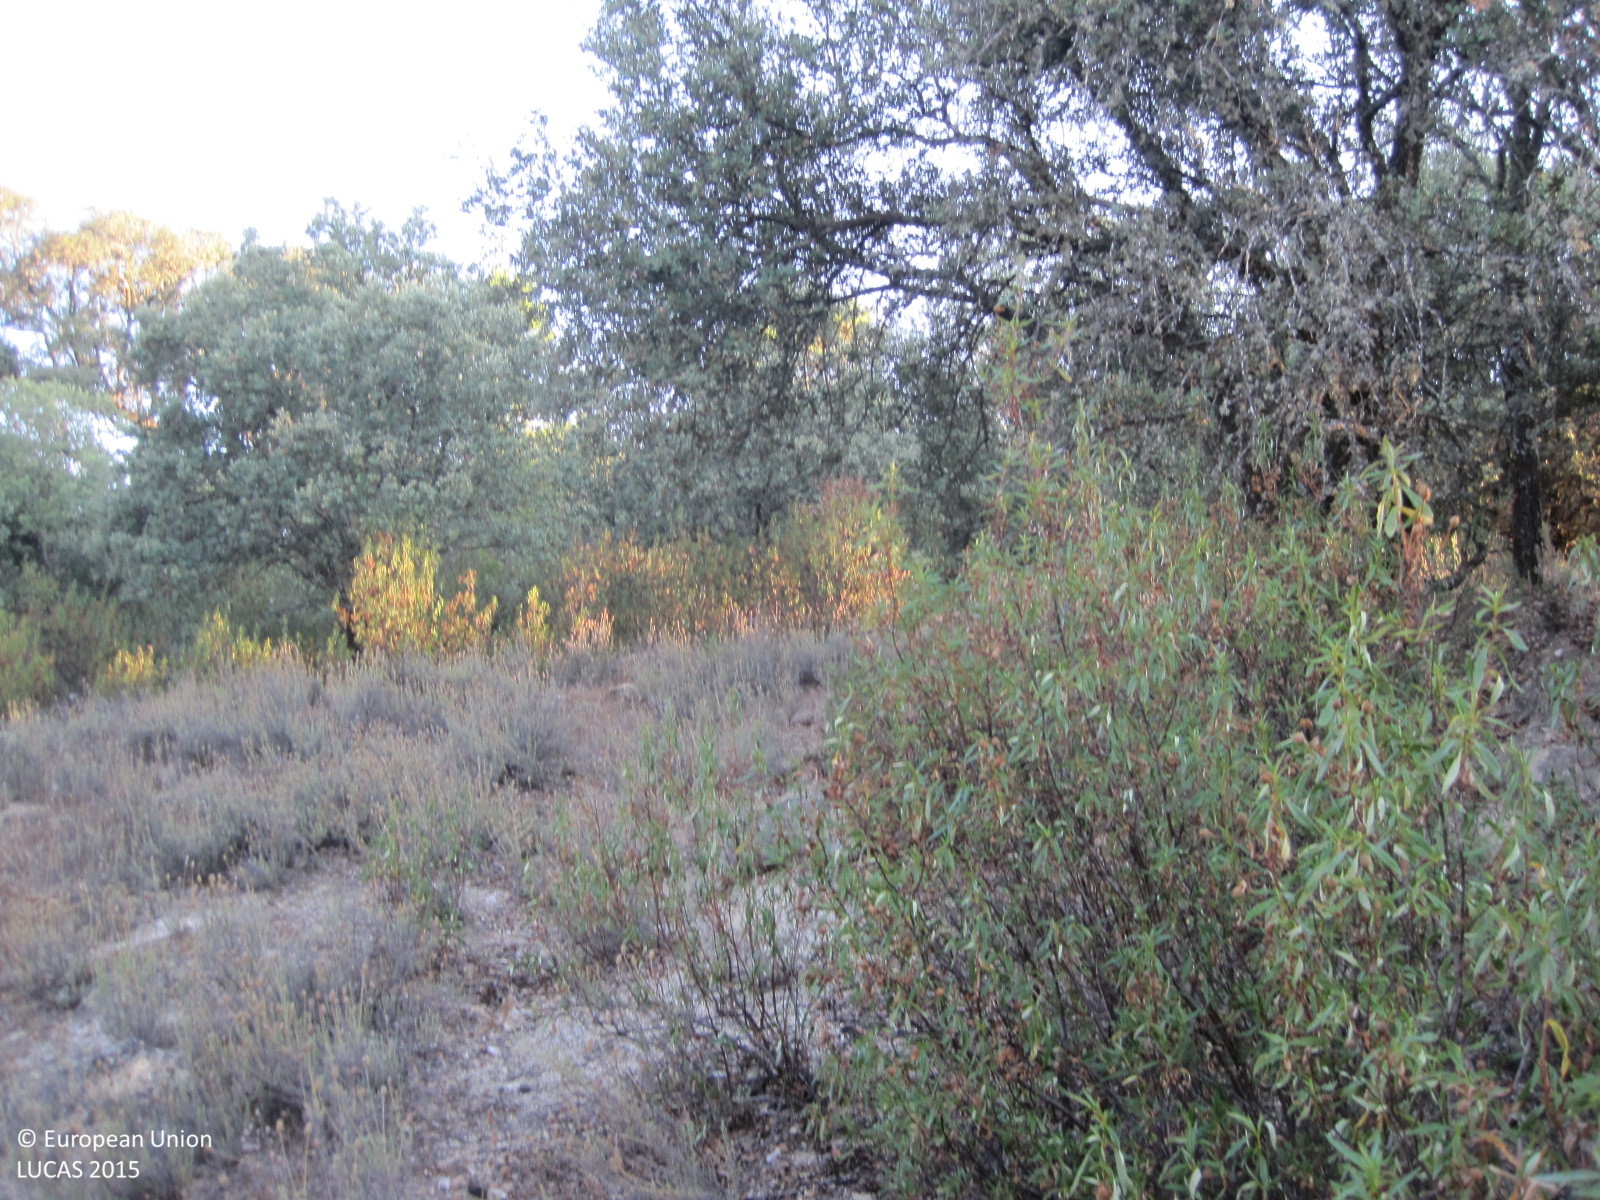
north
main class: Shrubland
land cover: Shrubland with sparse tree cover
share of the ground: > 75 %
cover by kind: shrubs 95 %, broadleaved forest trees 5 %
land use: Semi-natural and natural areas not in use
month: July
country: ES
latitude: 40.2495
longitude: -4.8534
